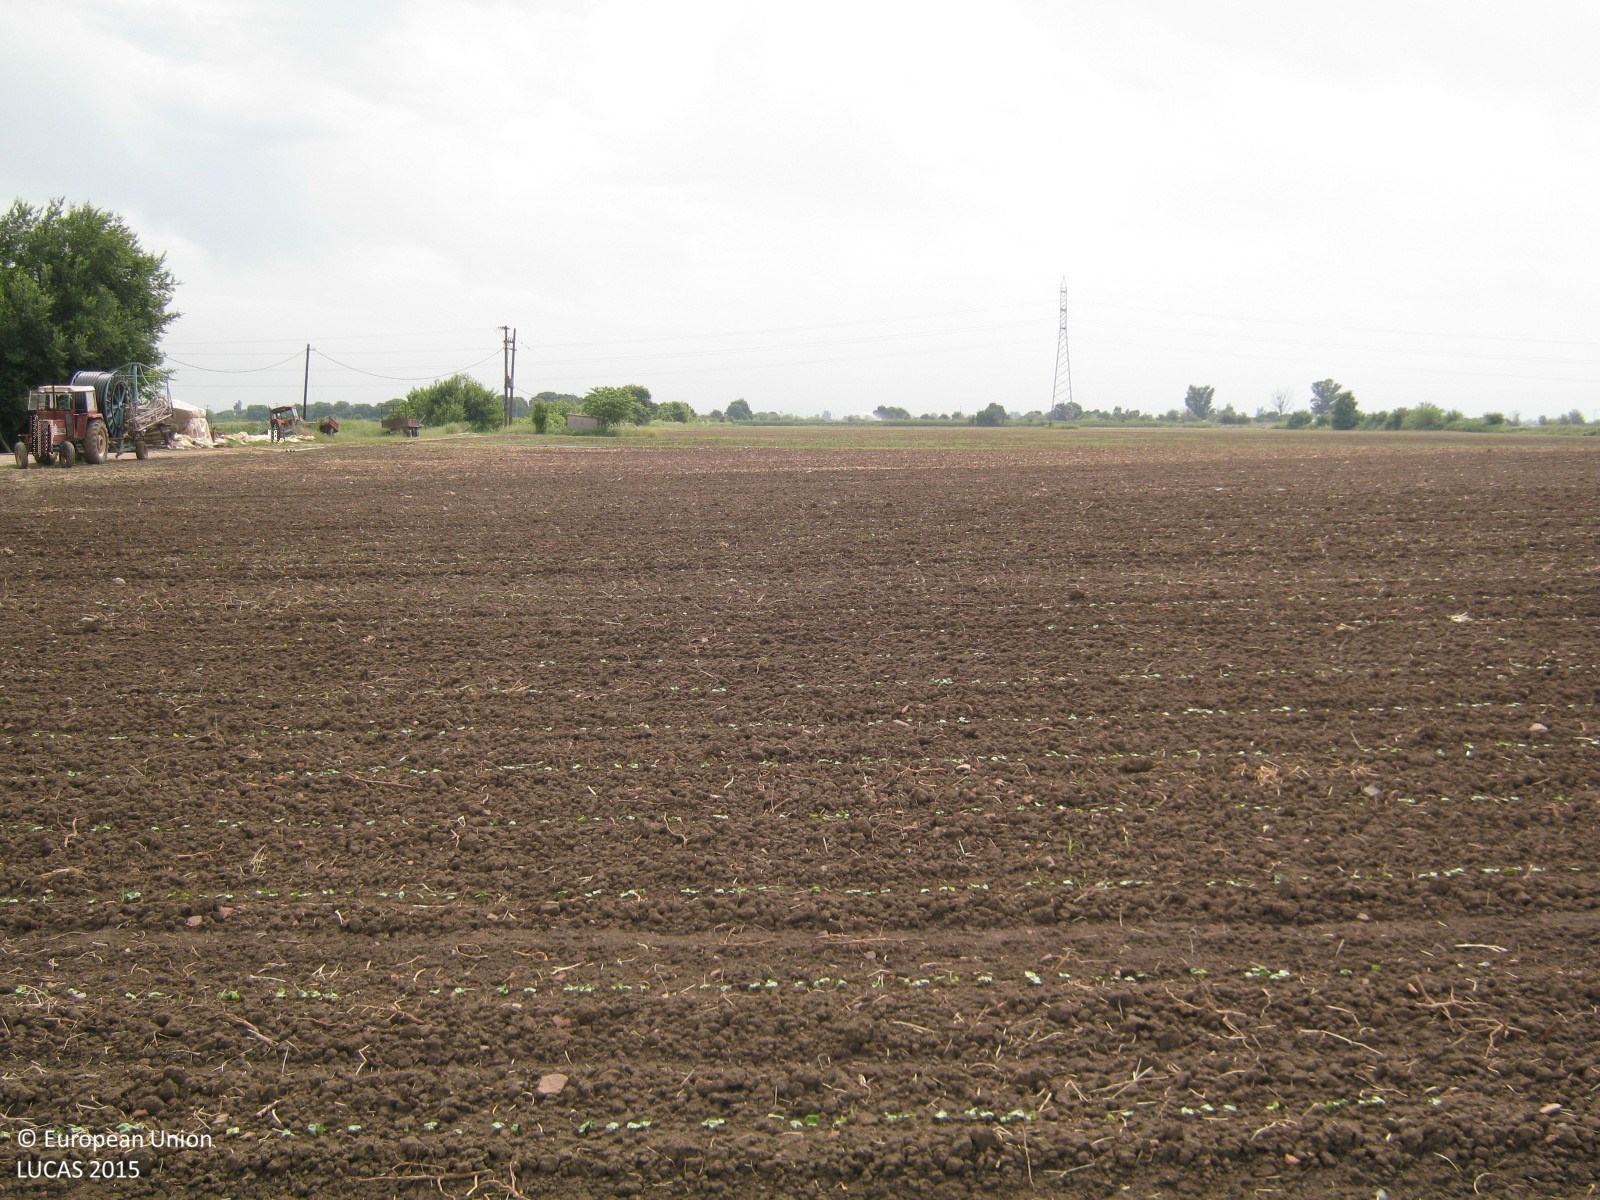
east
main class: Cropland
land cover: Cotton
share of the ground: < 10 %
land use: Agriculture (excluding fallow land and kitchen gardens)
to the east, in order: Cotton
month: May
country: GR
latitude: 39.4224
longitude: 21.8189
